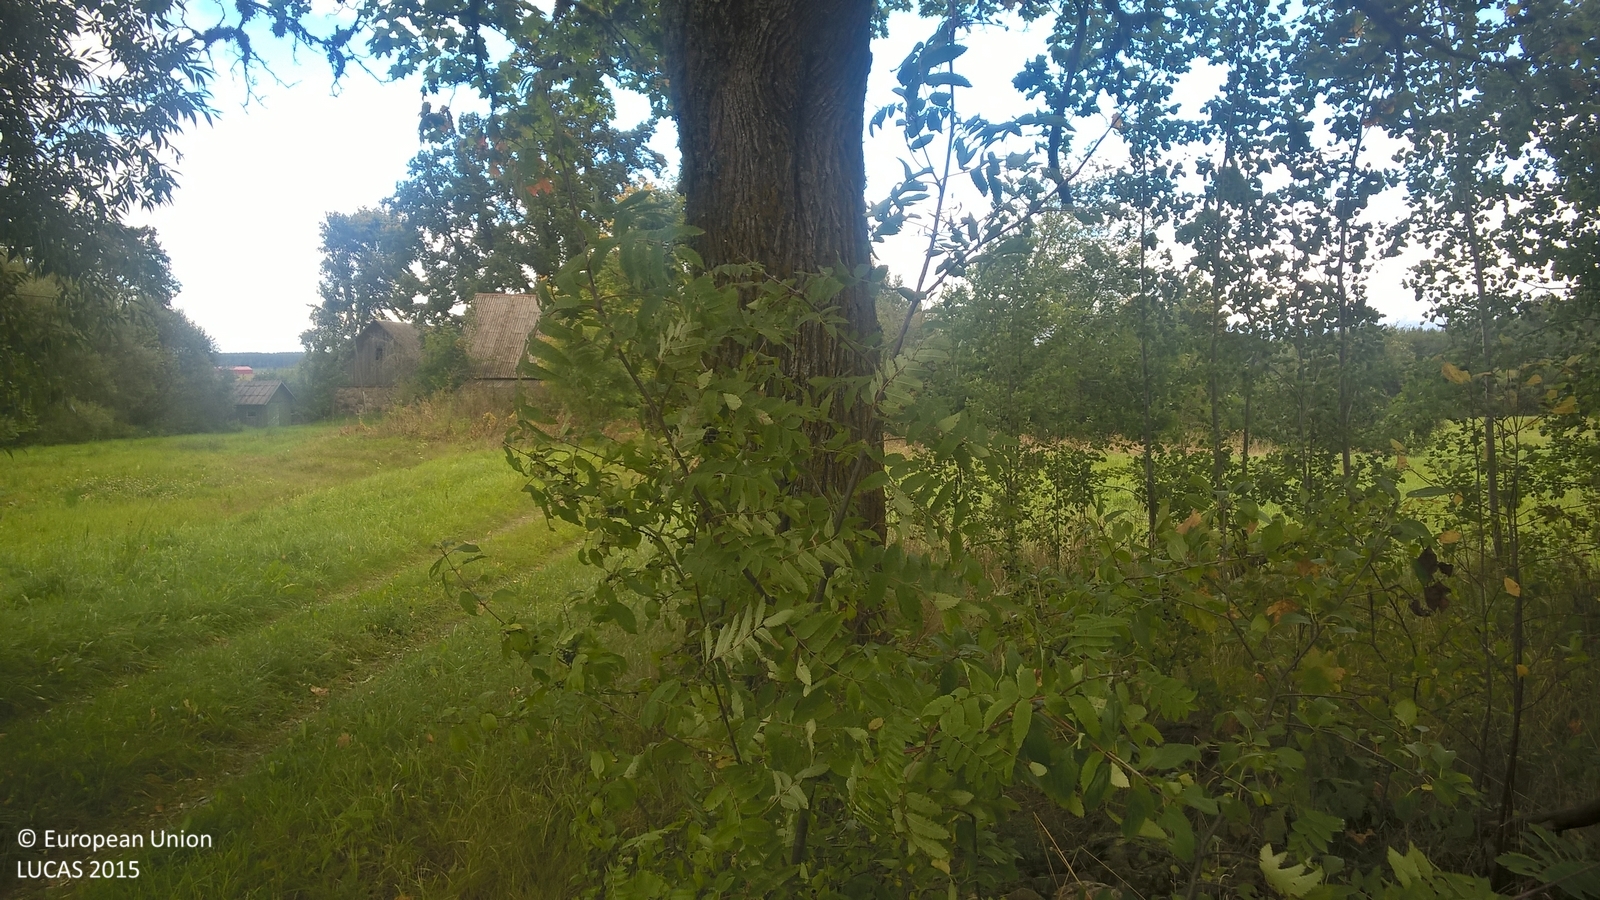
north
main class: Woodland
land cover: Broadleaved woodland
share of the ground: 10 - 25 %
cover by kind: herbaceous plants 70 %, broadleaved forest trees 20 %, shrubs 5 %, lichens and mosses 5 %
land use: Forestry
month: September
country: LV
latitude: 57.4603
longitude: 25.9461
